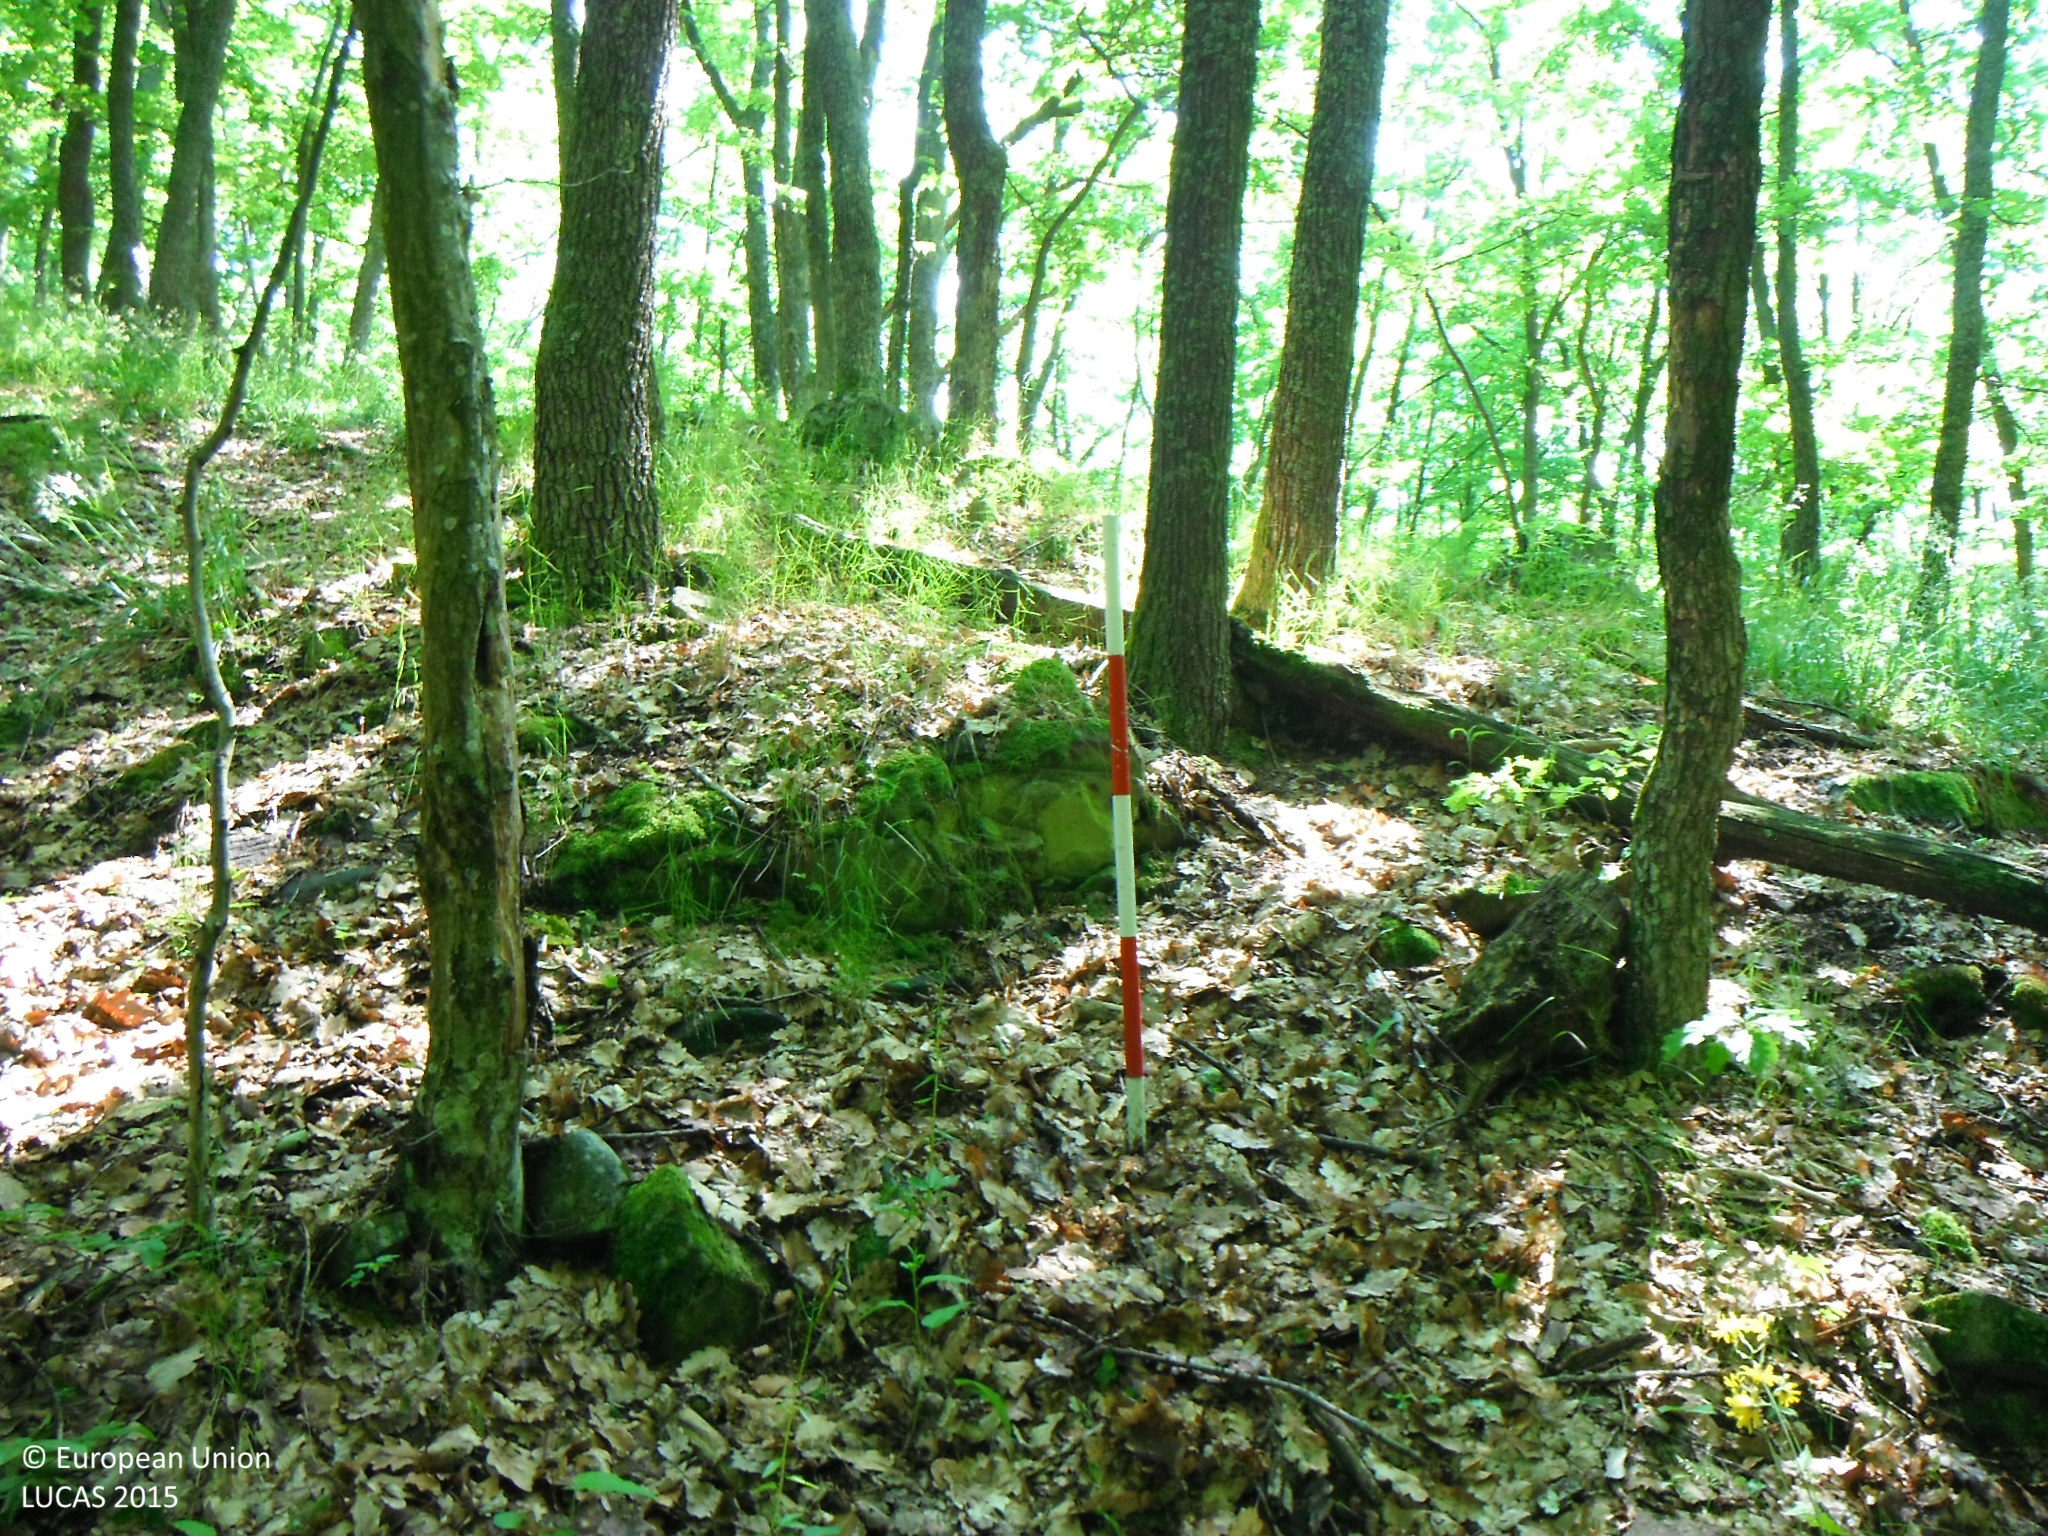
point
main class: Woodland
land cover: Broadleaved woodland
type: acidophilous oak and oak-birch forest
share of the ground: > 75 %
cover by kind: broadleaved forest trees 95 %, herbaceous plants 5 %
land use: Forestry
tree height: > 5 m
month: June
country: SK
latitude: 48.5981
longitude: 19.4214
